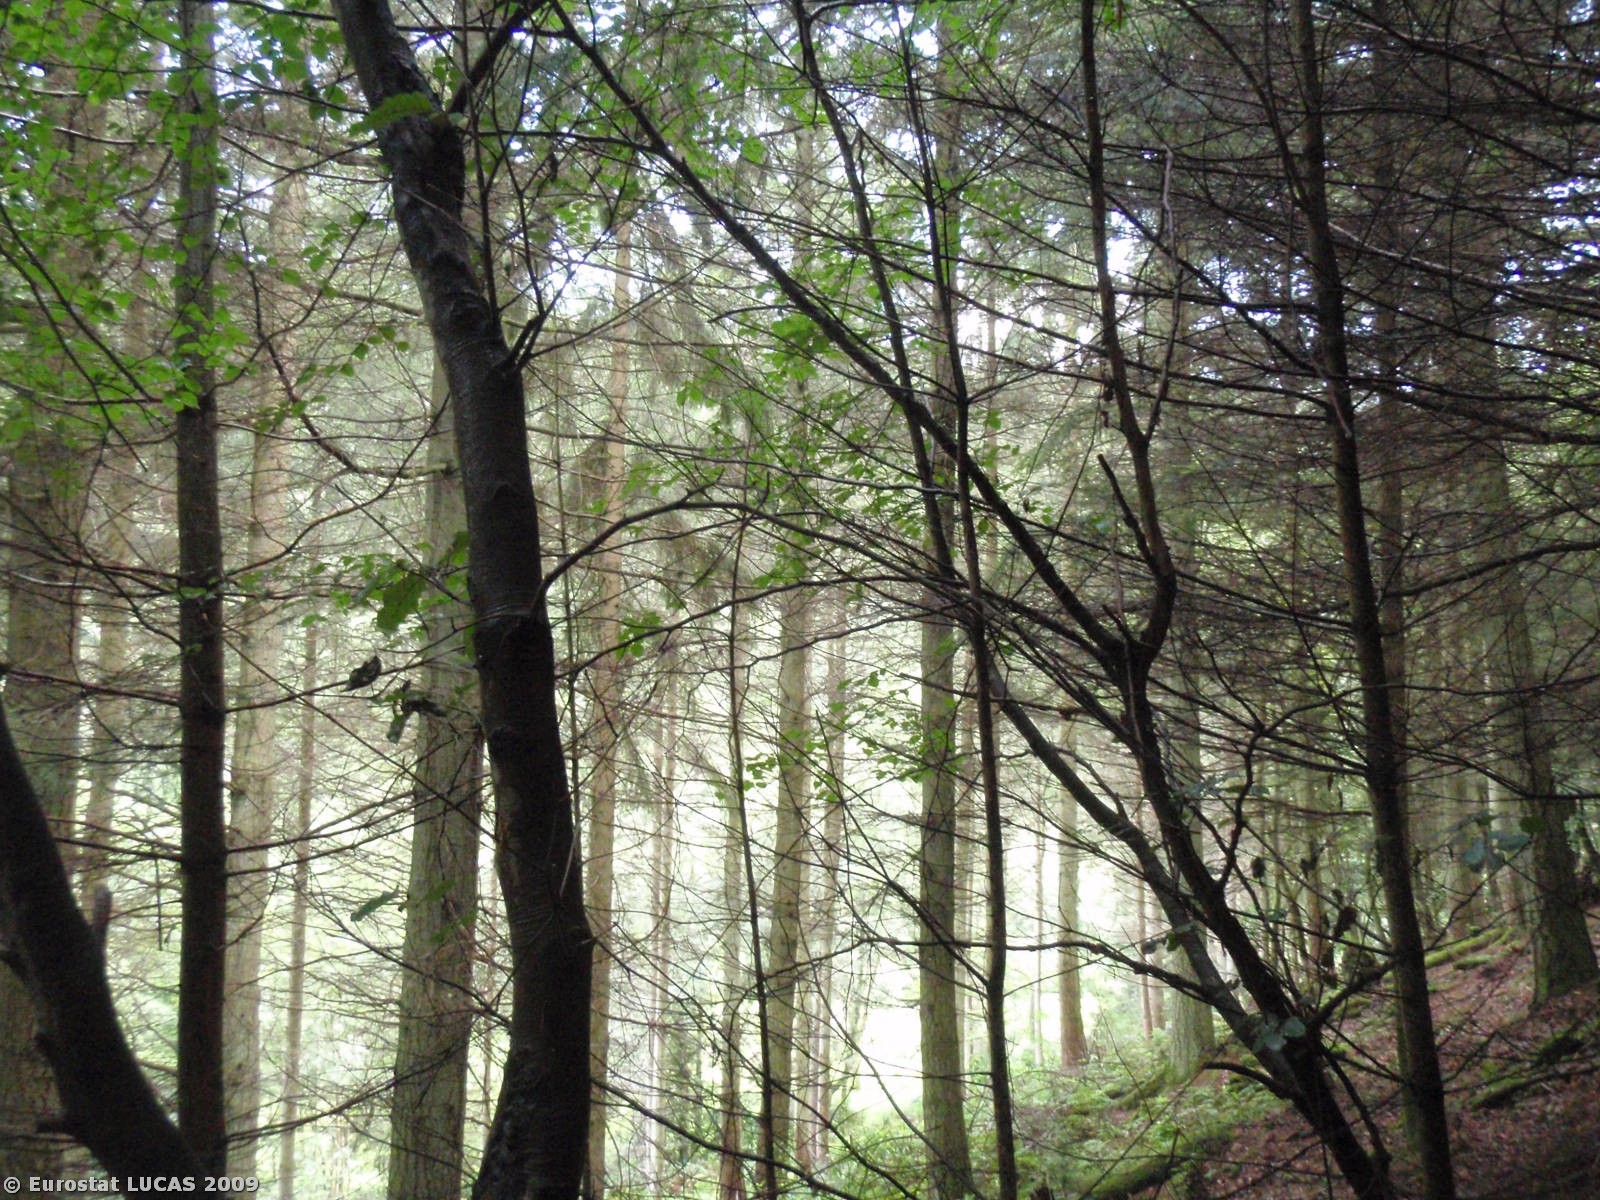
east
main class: Woodland
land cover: Coniferous woodland
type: plantations and self-sown exotic forest
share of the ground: > 75 %
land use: Forestry
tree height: > 5 m
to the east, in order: Coniferous woodland; Tracks; Broadleaved woodland; Fences; Grassland without tree/shrub cover; Rivers and streams; Broadleaved woodland; Tracks; Coniferous woodland
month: August
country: GB
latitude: 51.1691
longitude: -3.4557
